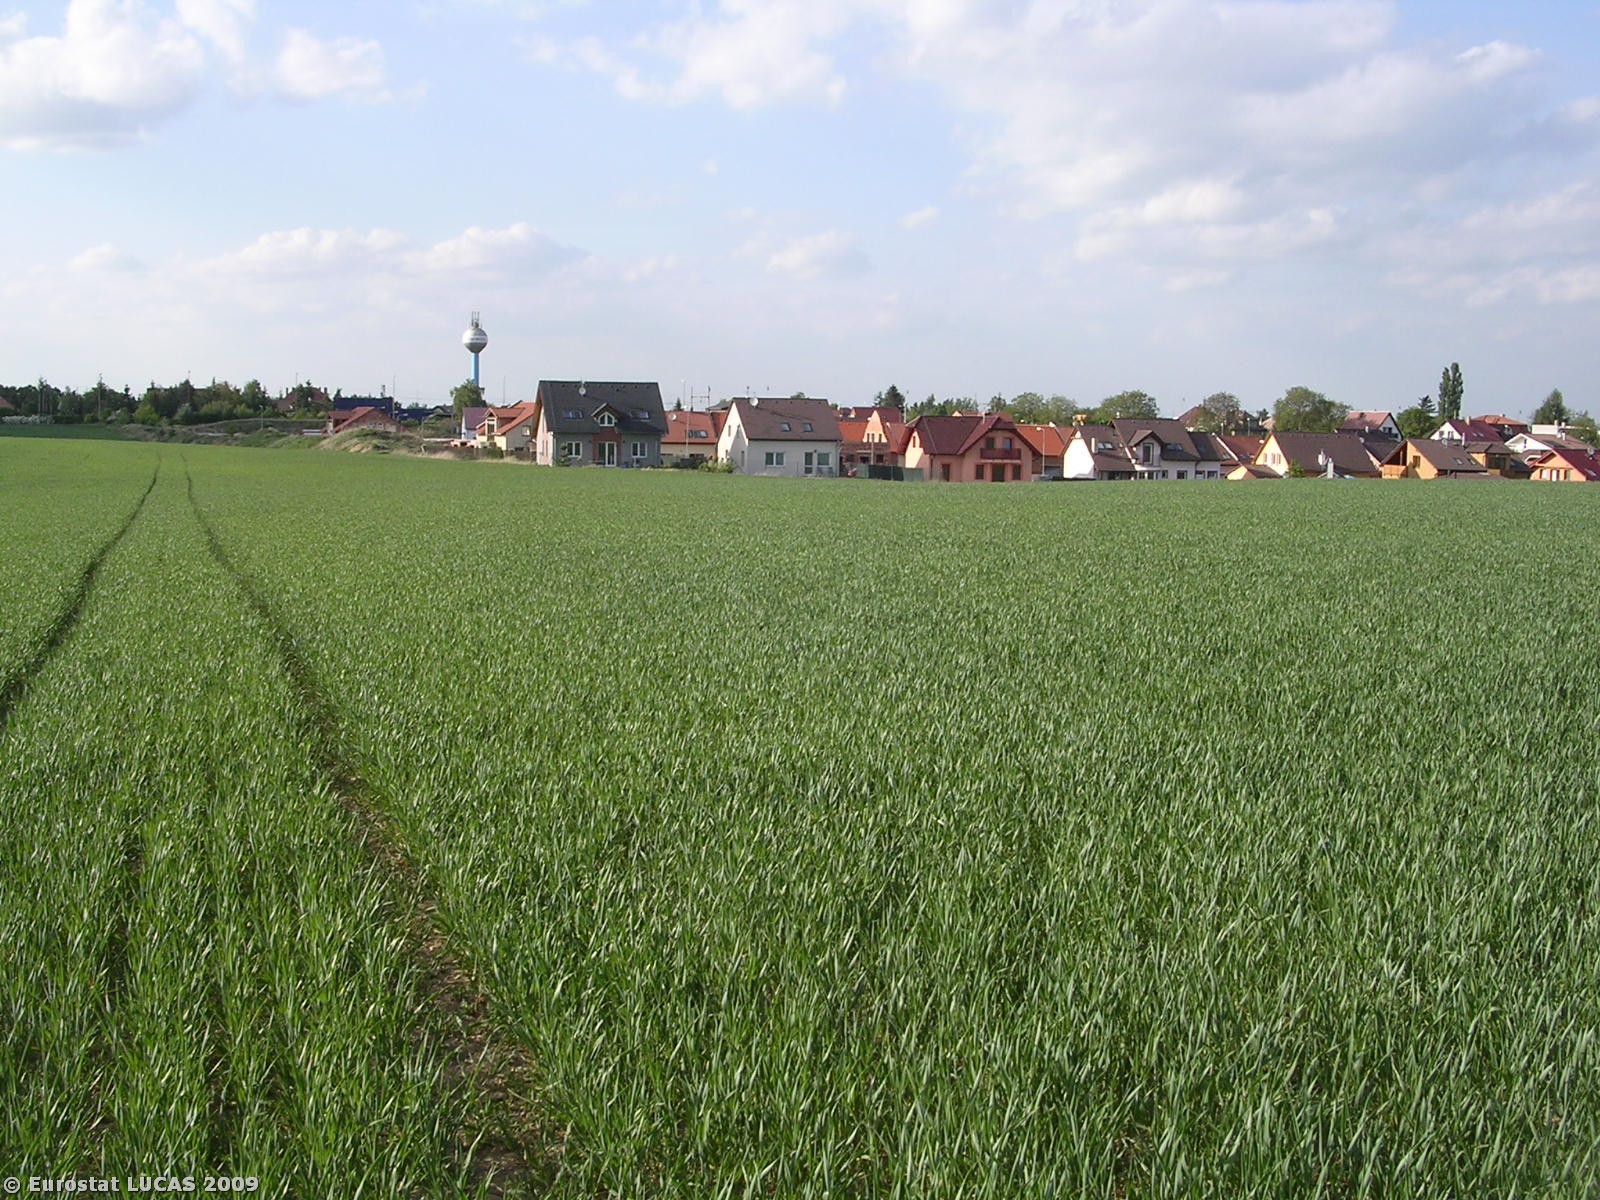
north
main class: Cropland
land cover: Common wheat
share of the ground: > 75 %
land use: Agriculture (excluding fallow land and kitchen gardens)
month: May
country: CZ
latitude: 50.1251
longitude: 14.6599
